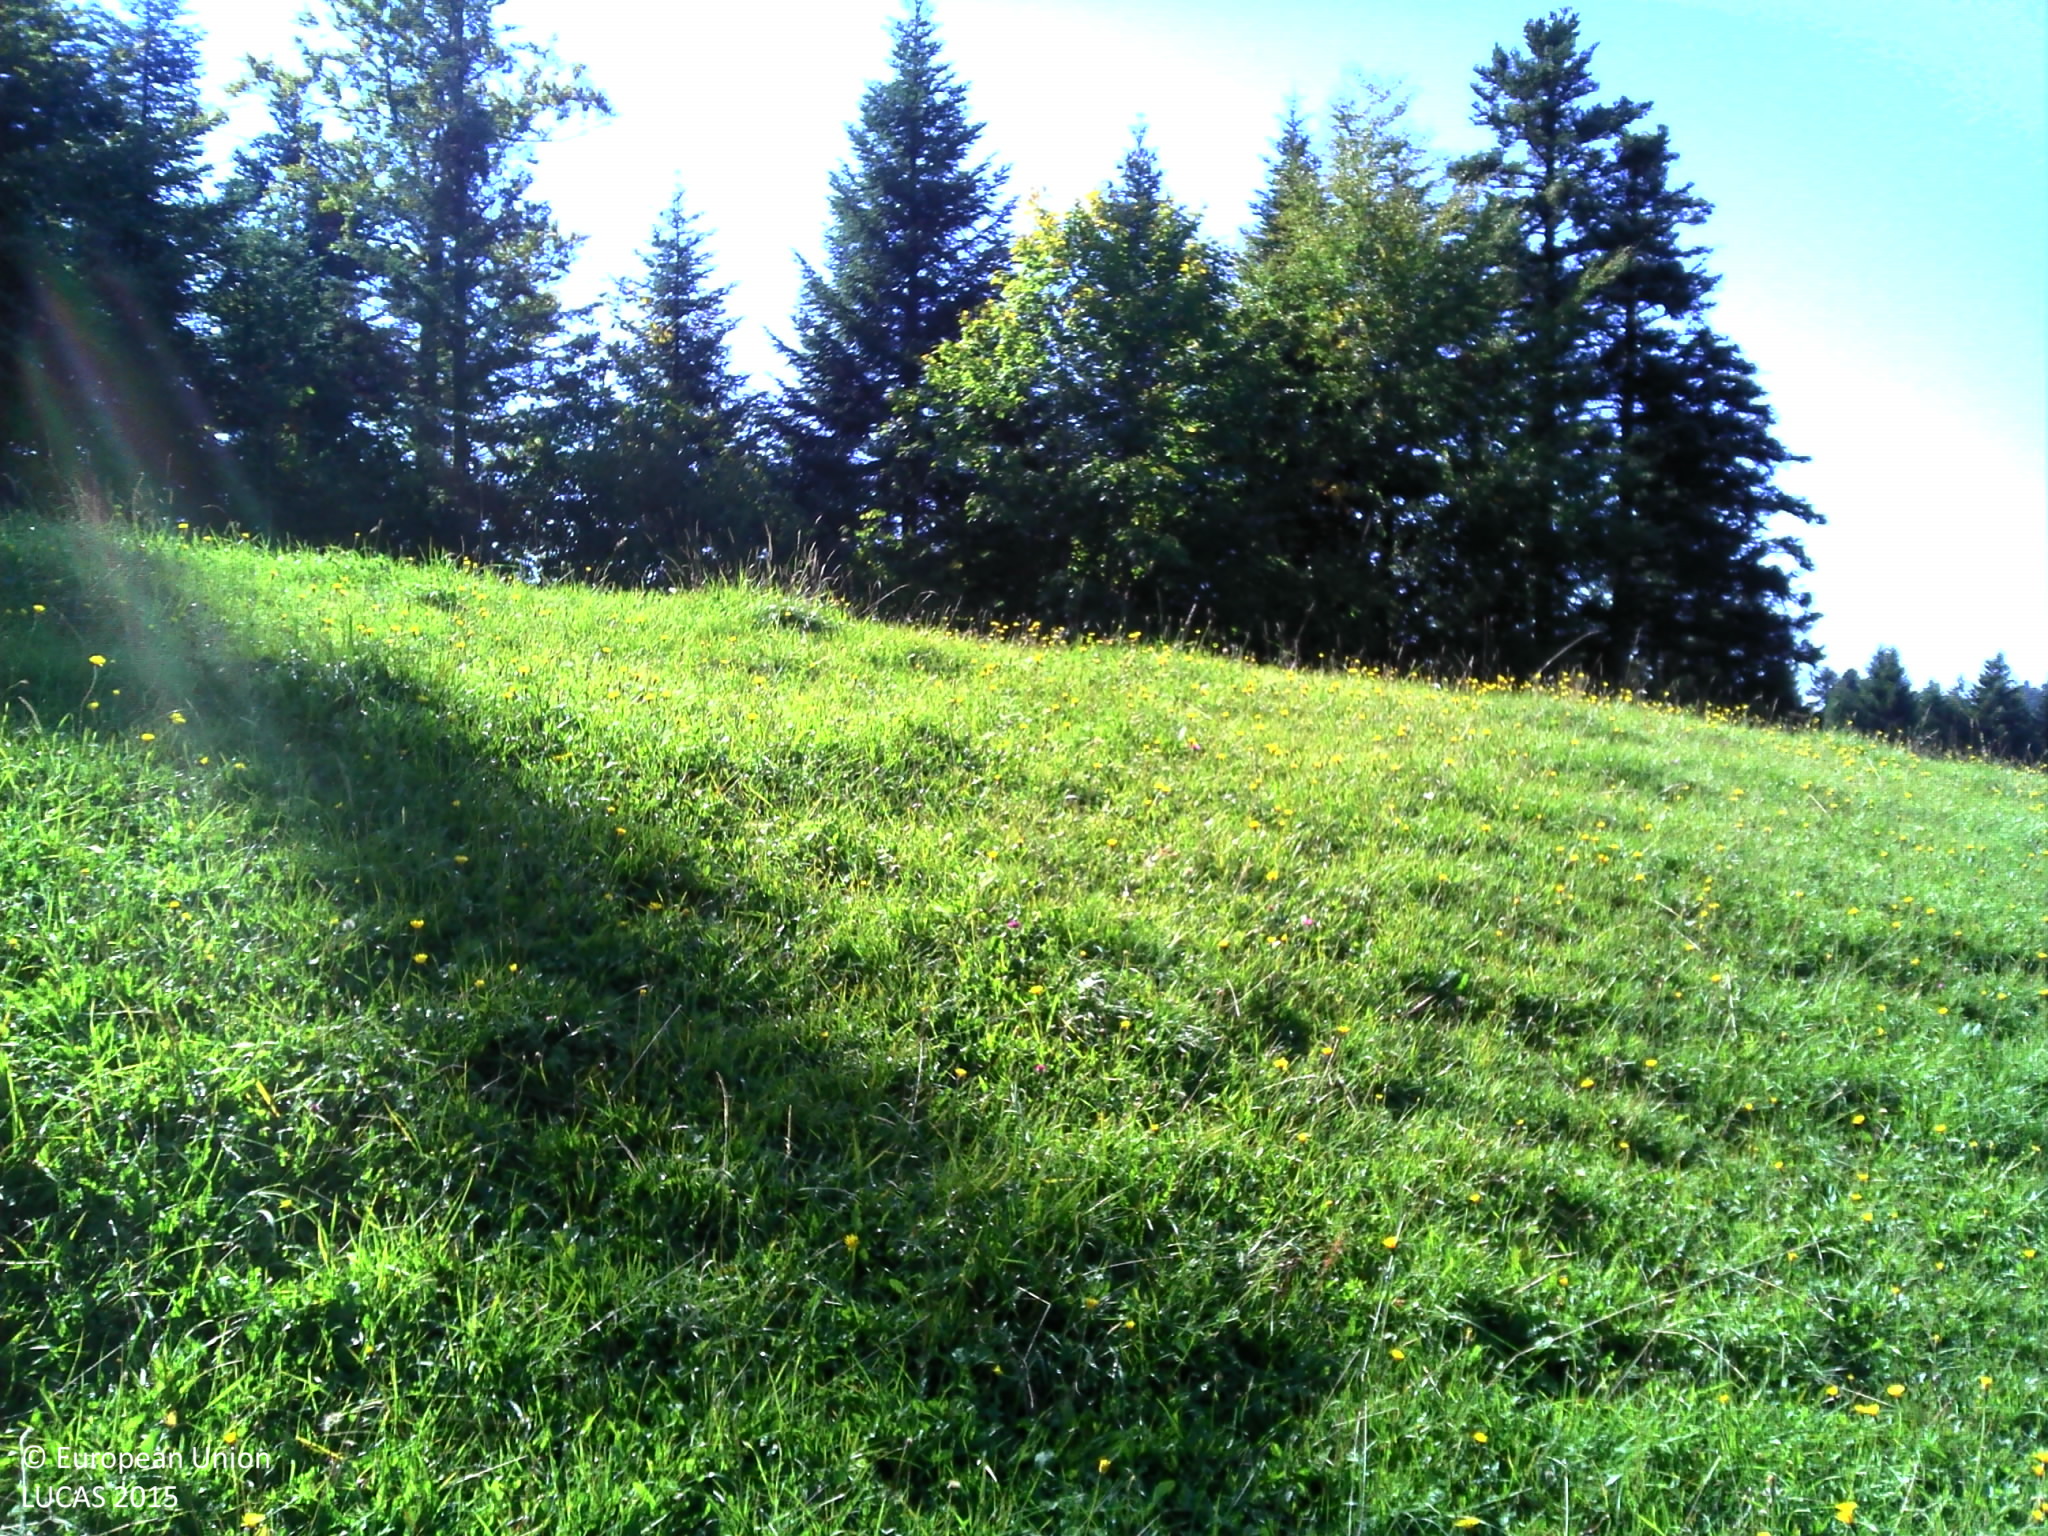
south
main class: Grassland
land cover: Grassland without tree/shrub cover
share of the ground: > 75 %
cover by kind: herbaceous plants 100 %
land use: Agriculture (excluding fallow land and kitchen gardens)
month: September
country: FR
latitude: 47.0831
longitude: 6.3800
